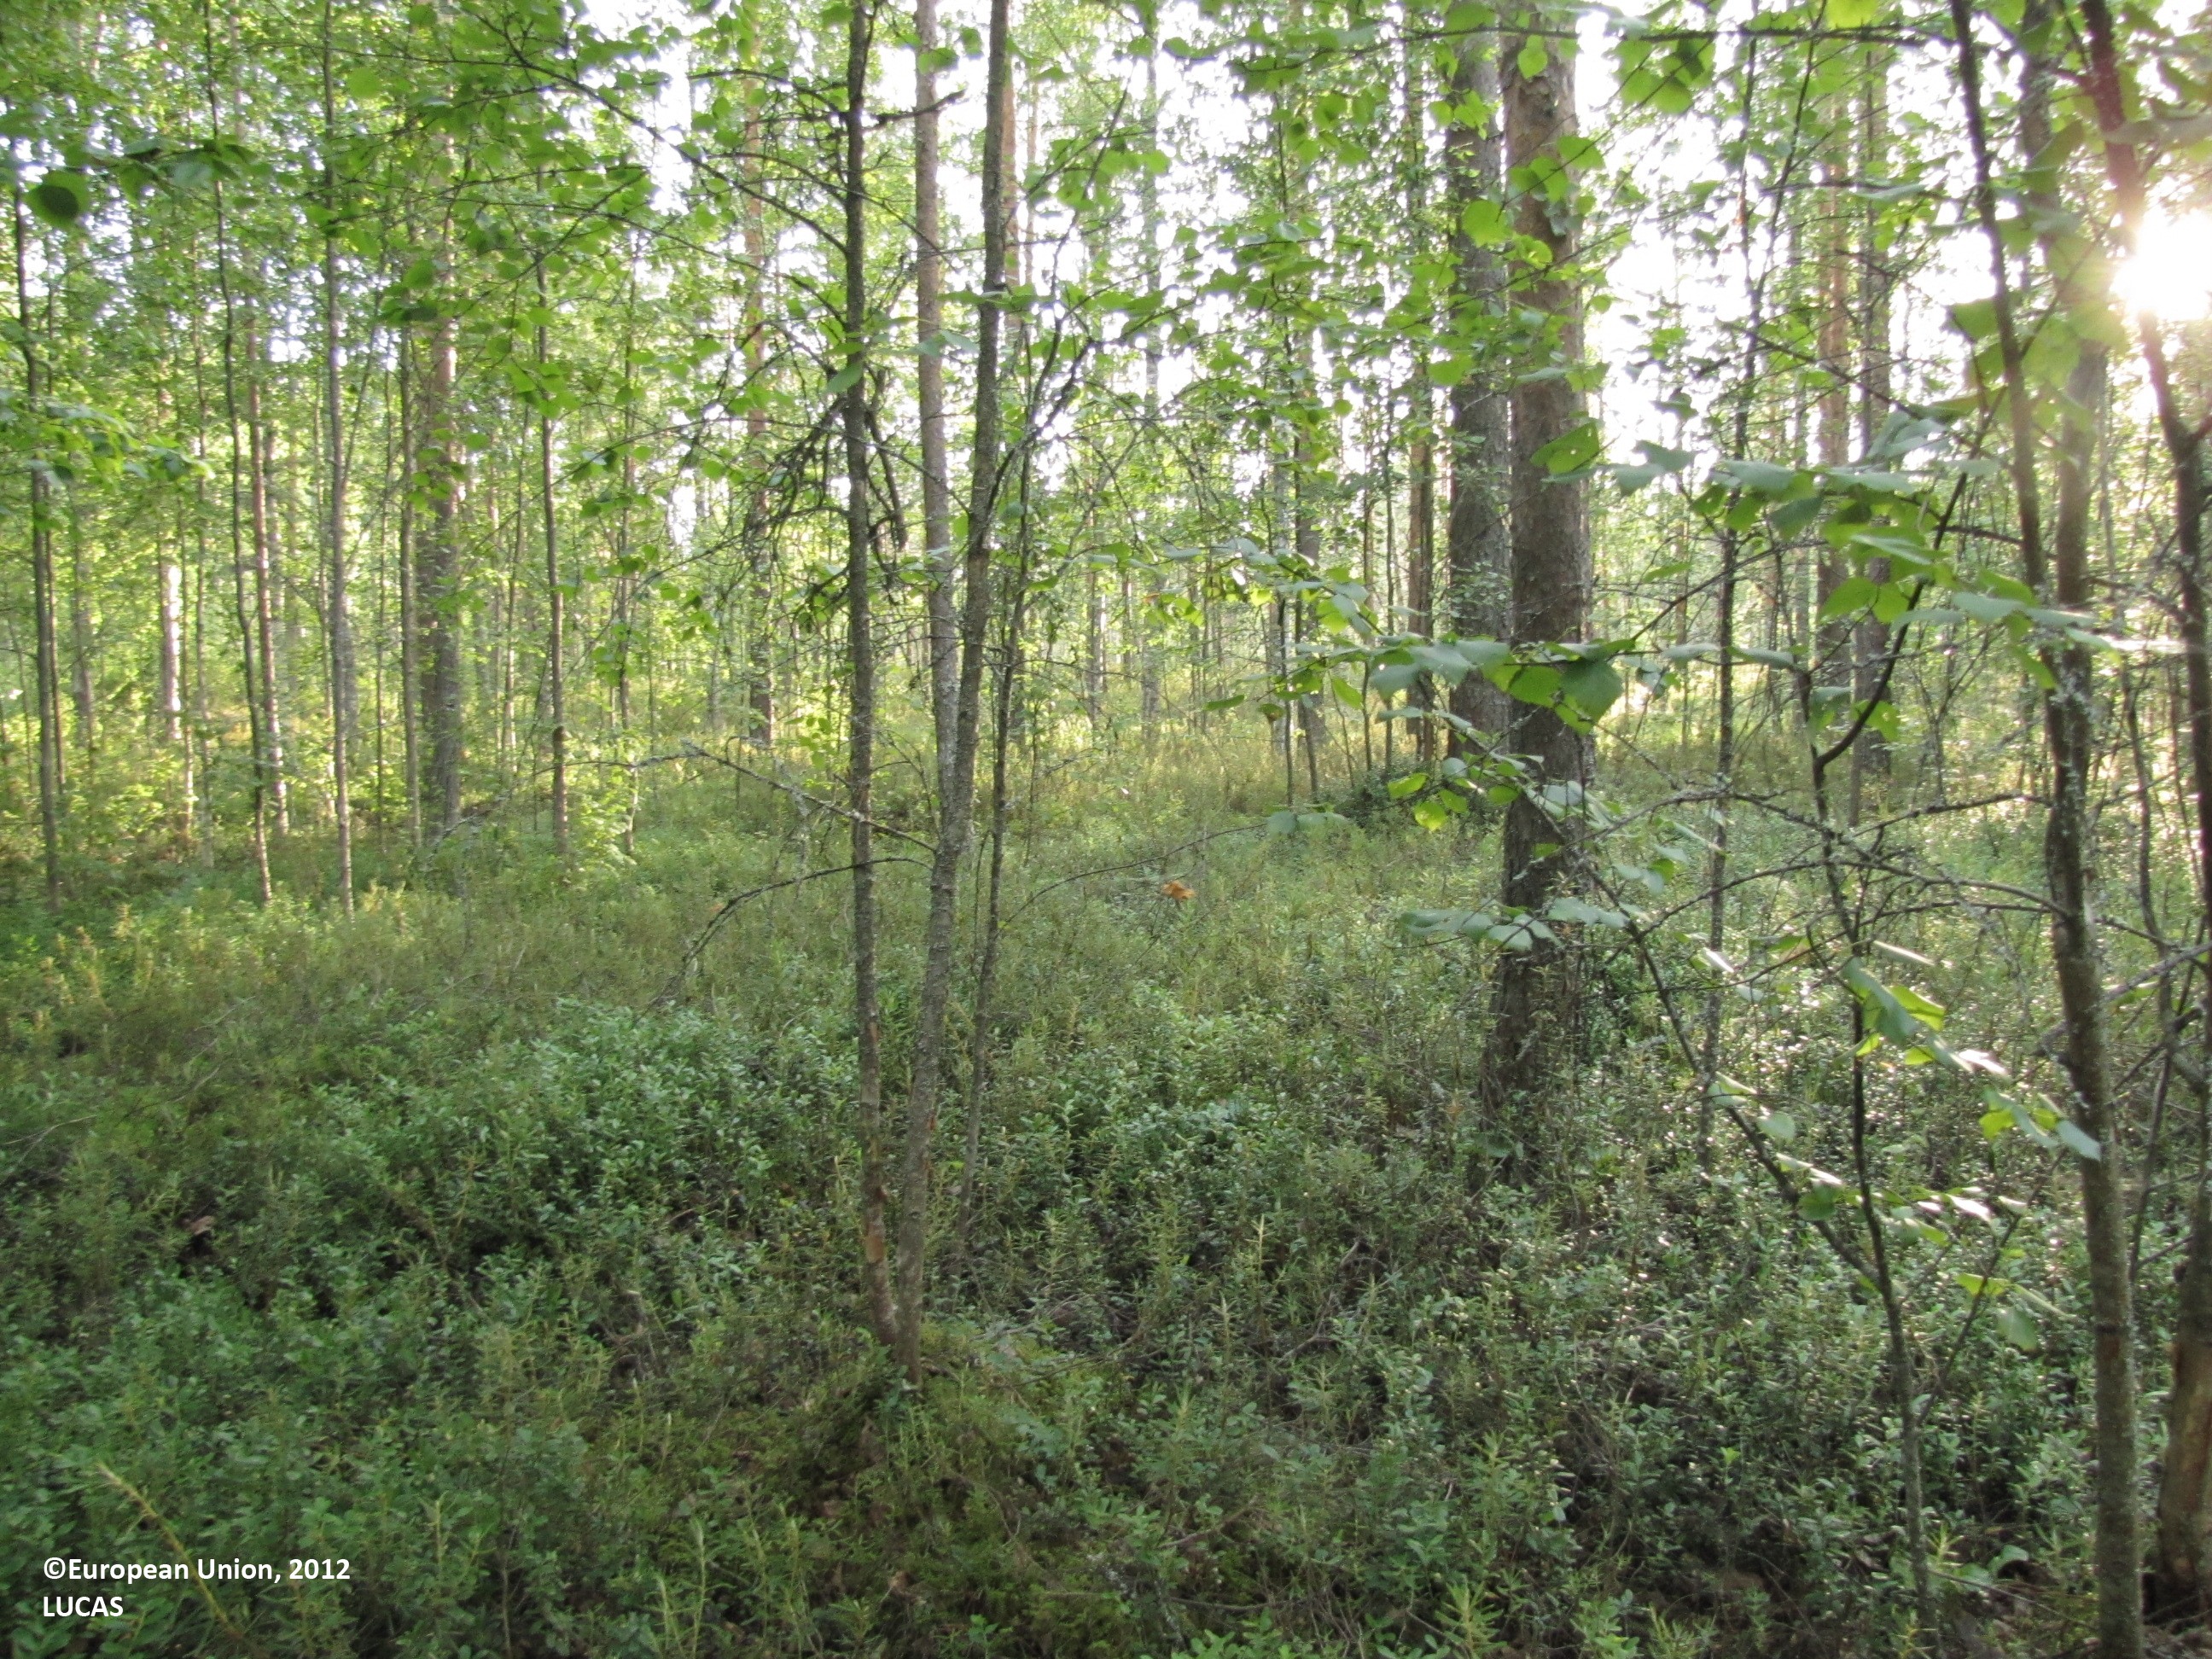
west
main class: Woodland
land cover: Pine dominated mixed woodland
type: mire and swamp forests
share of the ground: > 75 %
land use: Forestry
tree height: > 5 m
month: July
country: FI
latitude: 62.5925
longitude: 23.4473
